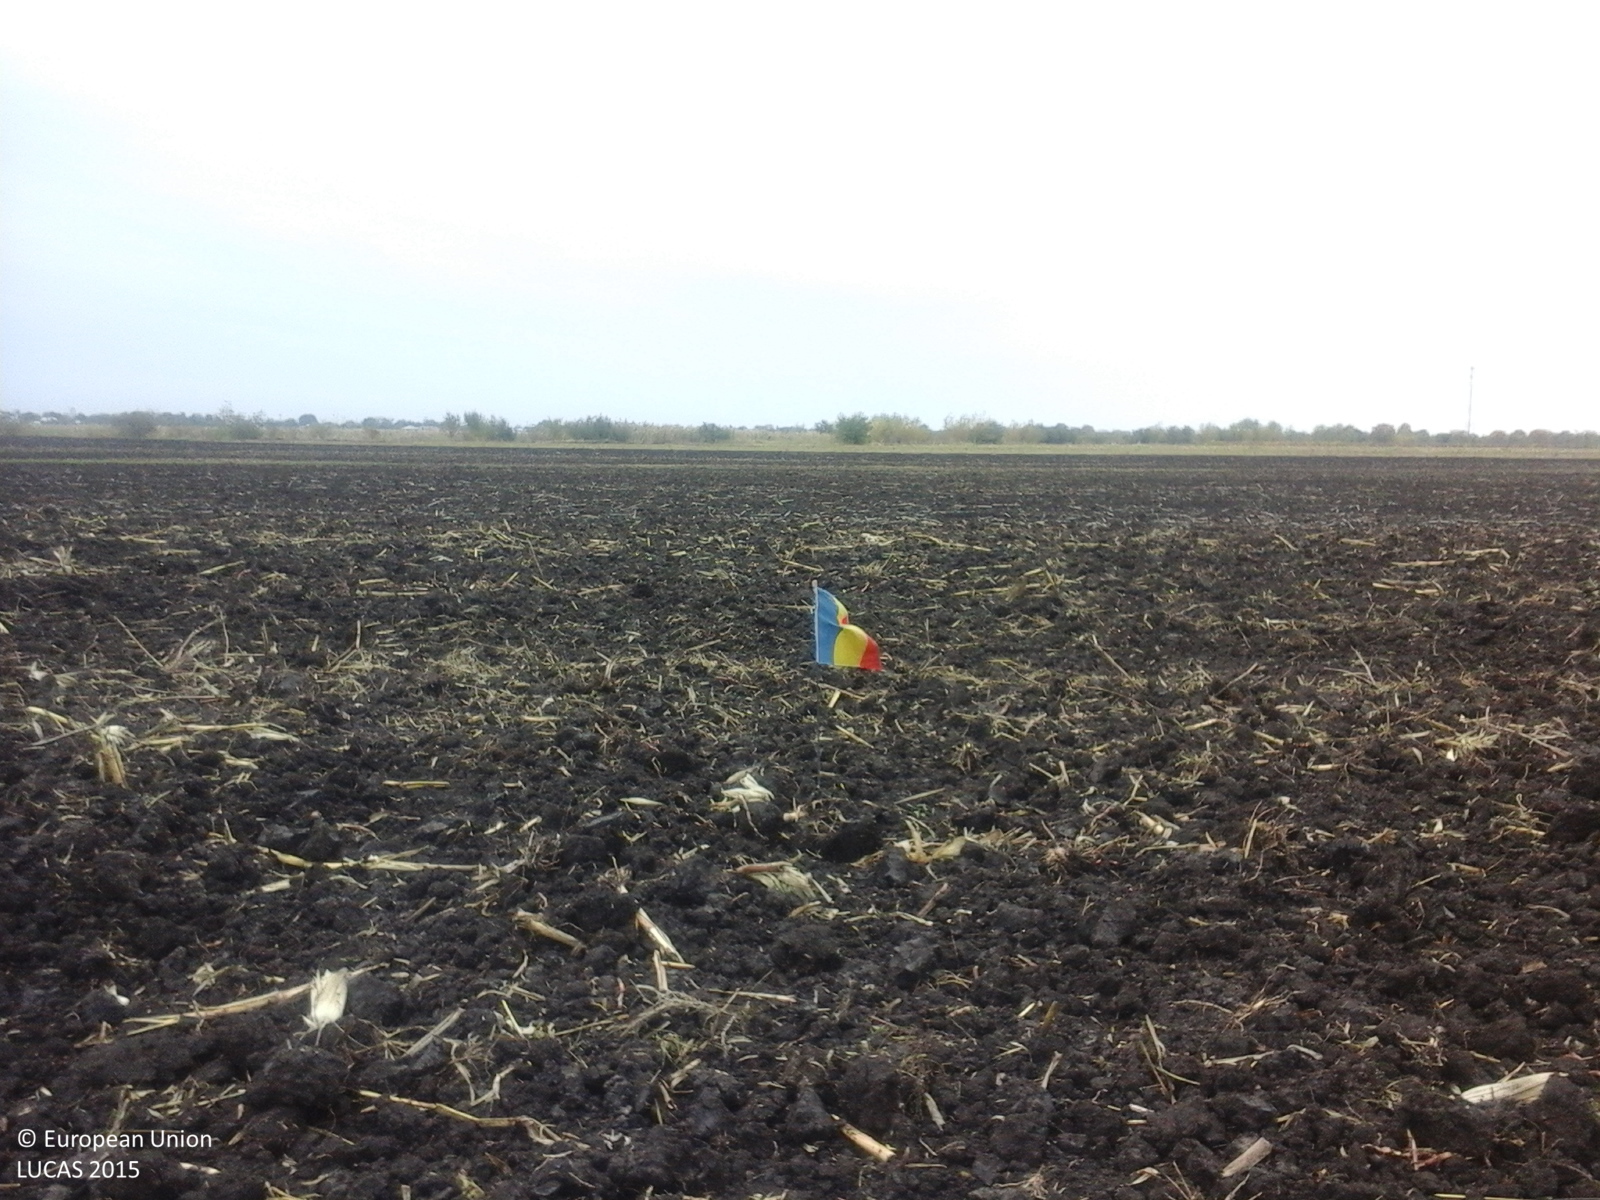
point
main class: Cropland
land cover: Maize
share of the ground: 10 - 25 %
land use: Agriculture (excluding fallow land and kitchen gardens)
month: October
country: RO
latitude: 44.9491
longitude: 26.3787
